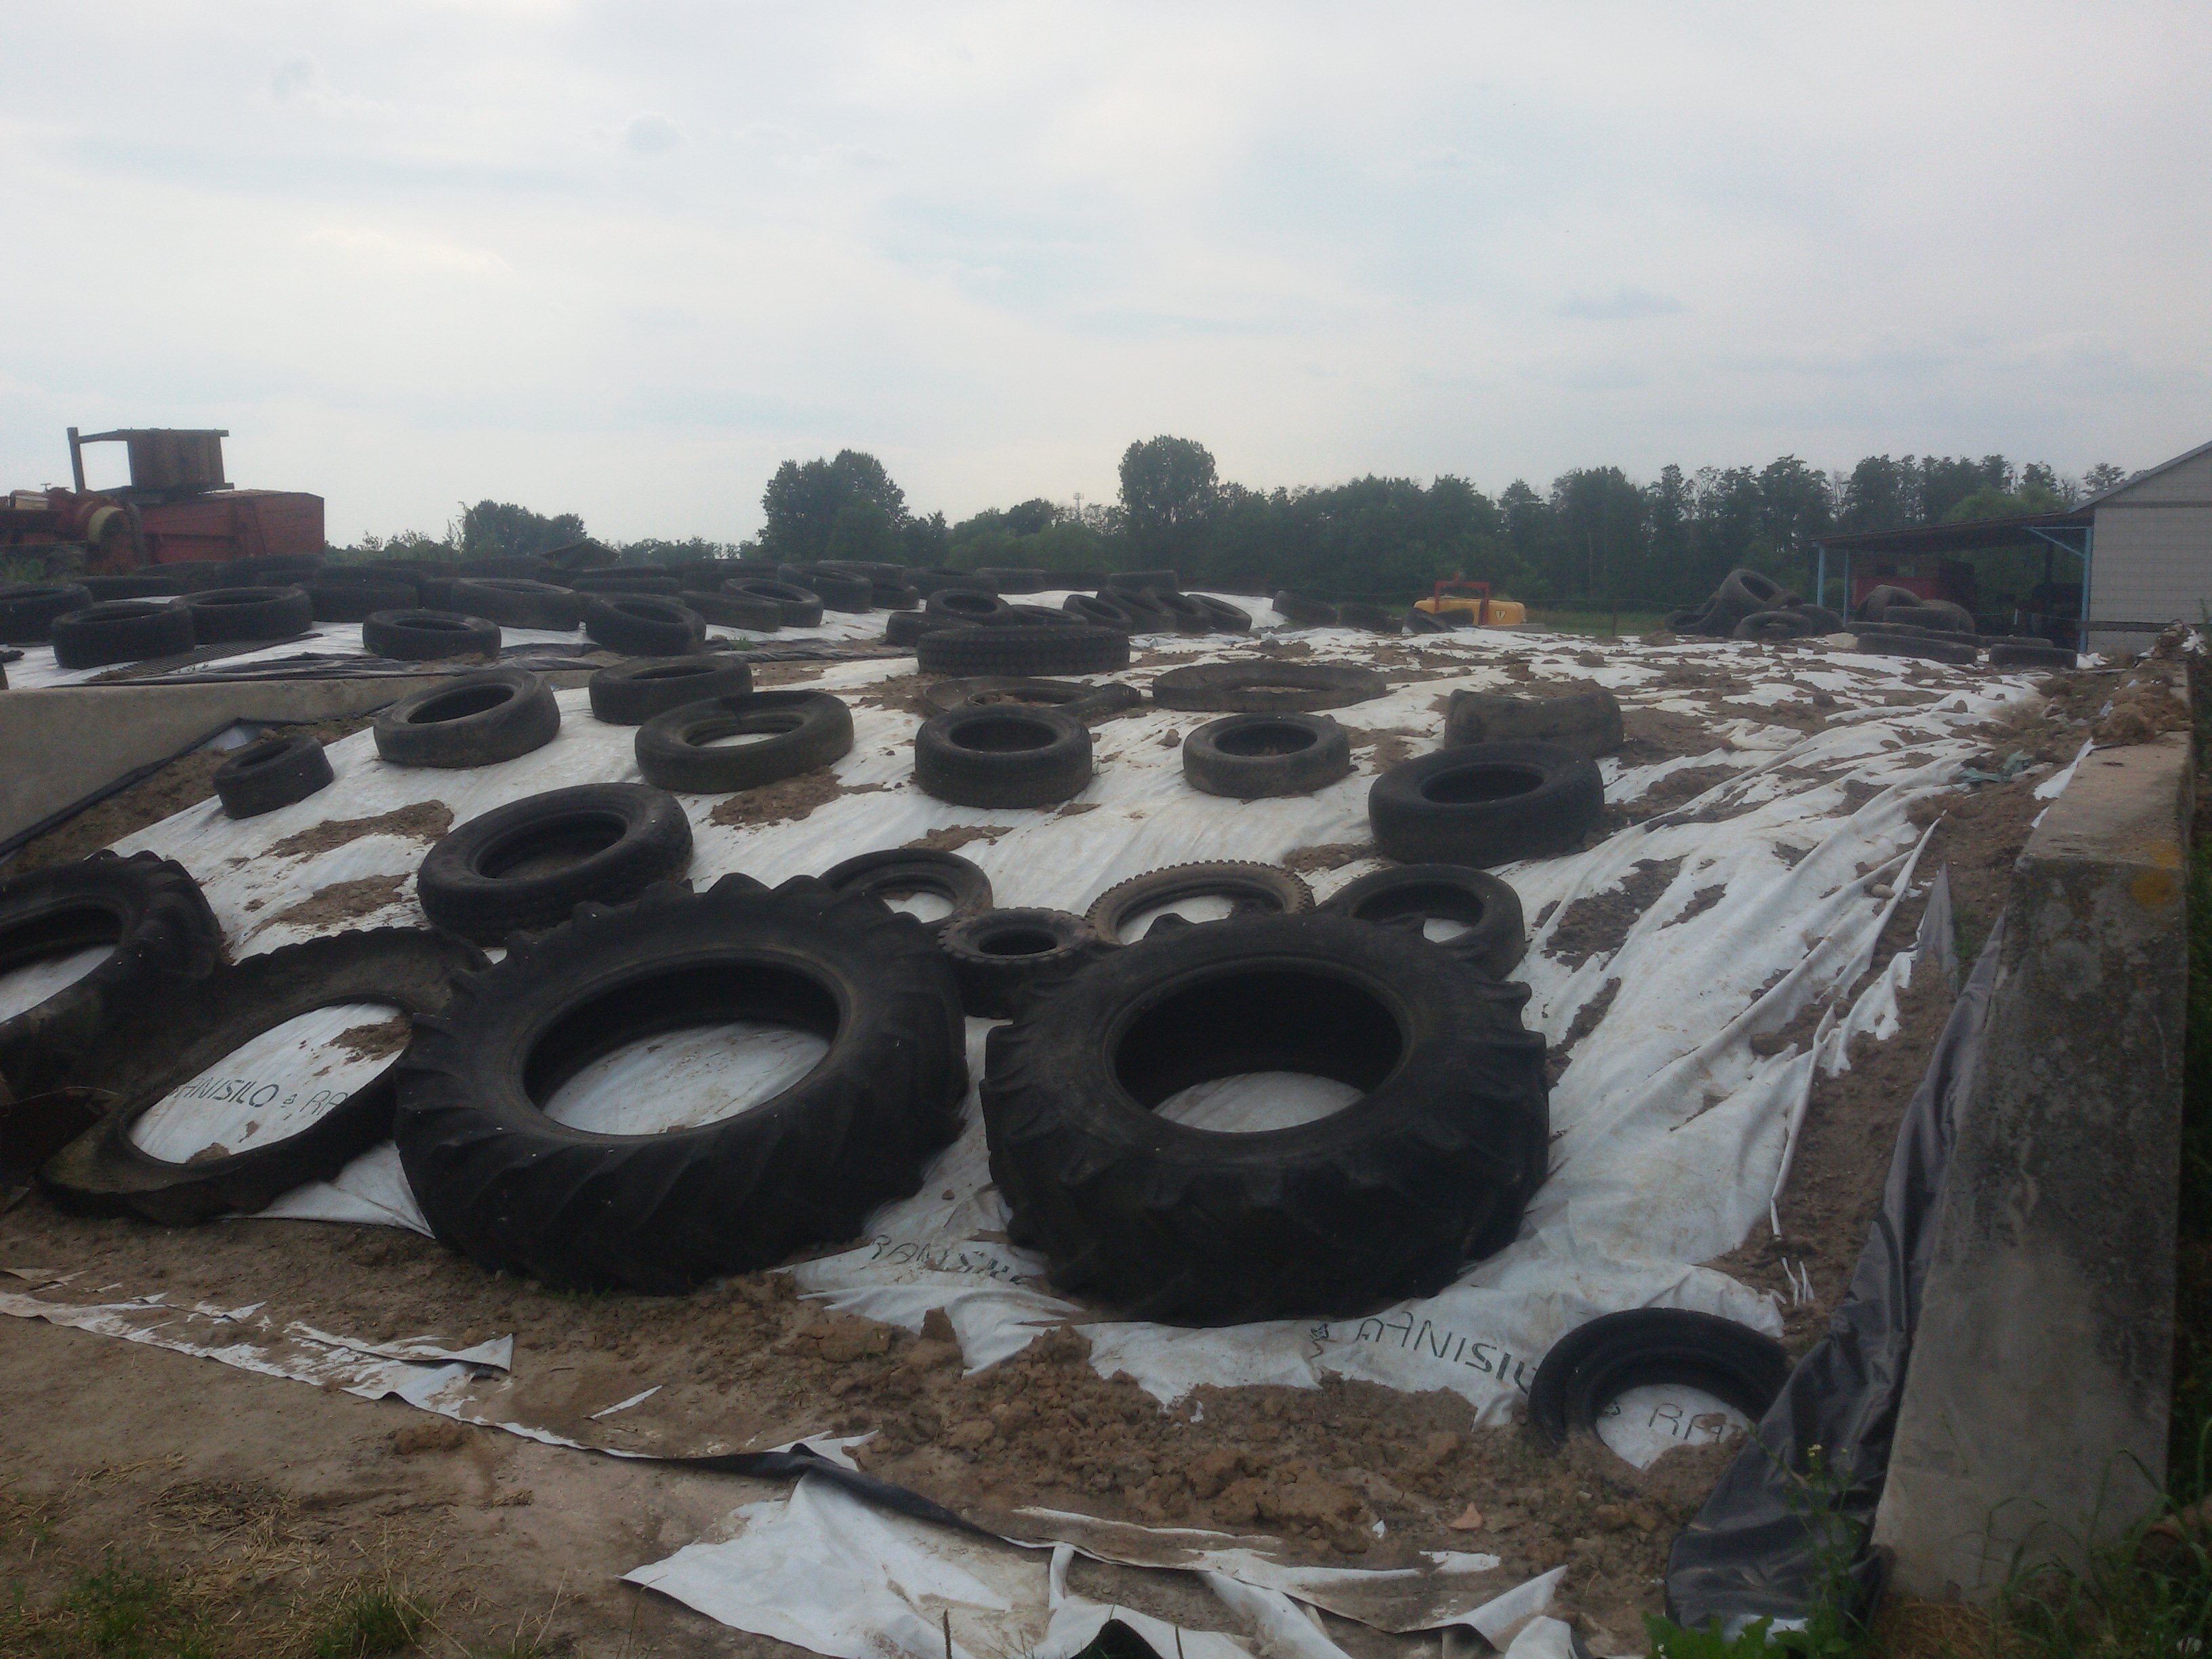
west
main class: Grassland
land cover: Spontaneously vegetated surfaces
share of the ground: 50 - 75 %
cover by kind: herbaceous plants 55 %, unconsolidated bare surface 45 %
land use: Agriculture (excluding fallow land and kitchen gardens)
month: May
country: PL
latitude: 52.8349
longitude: 22.2187
